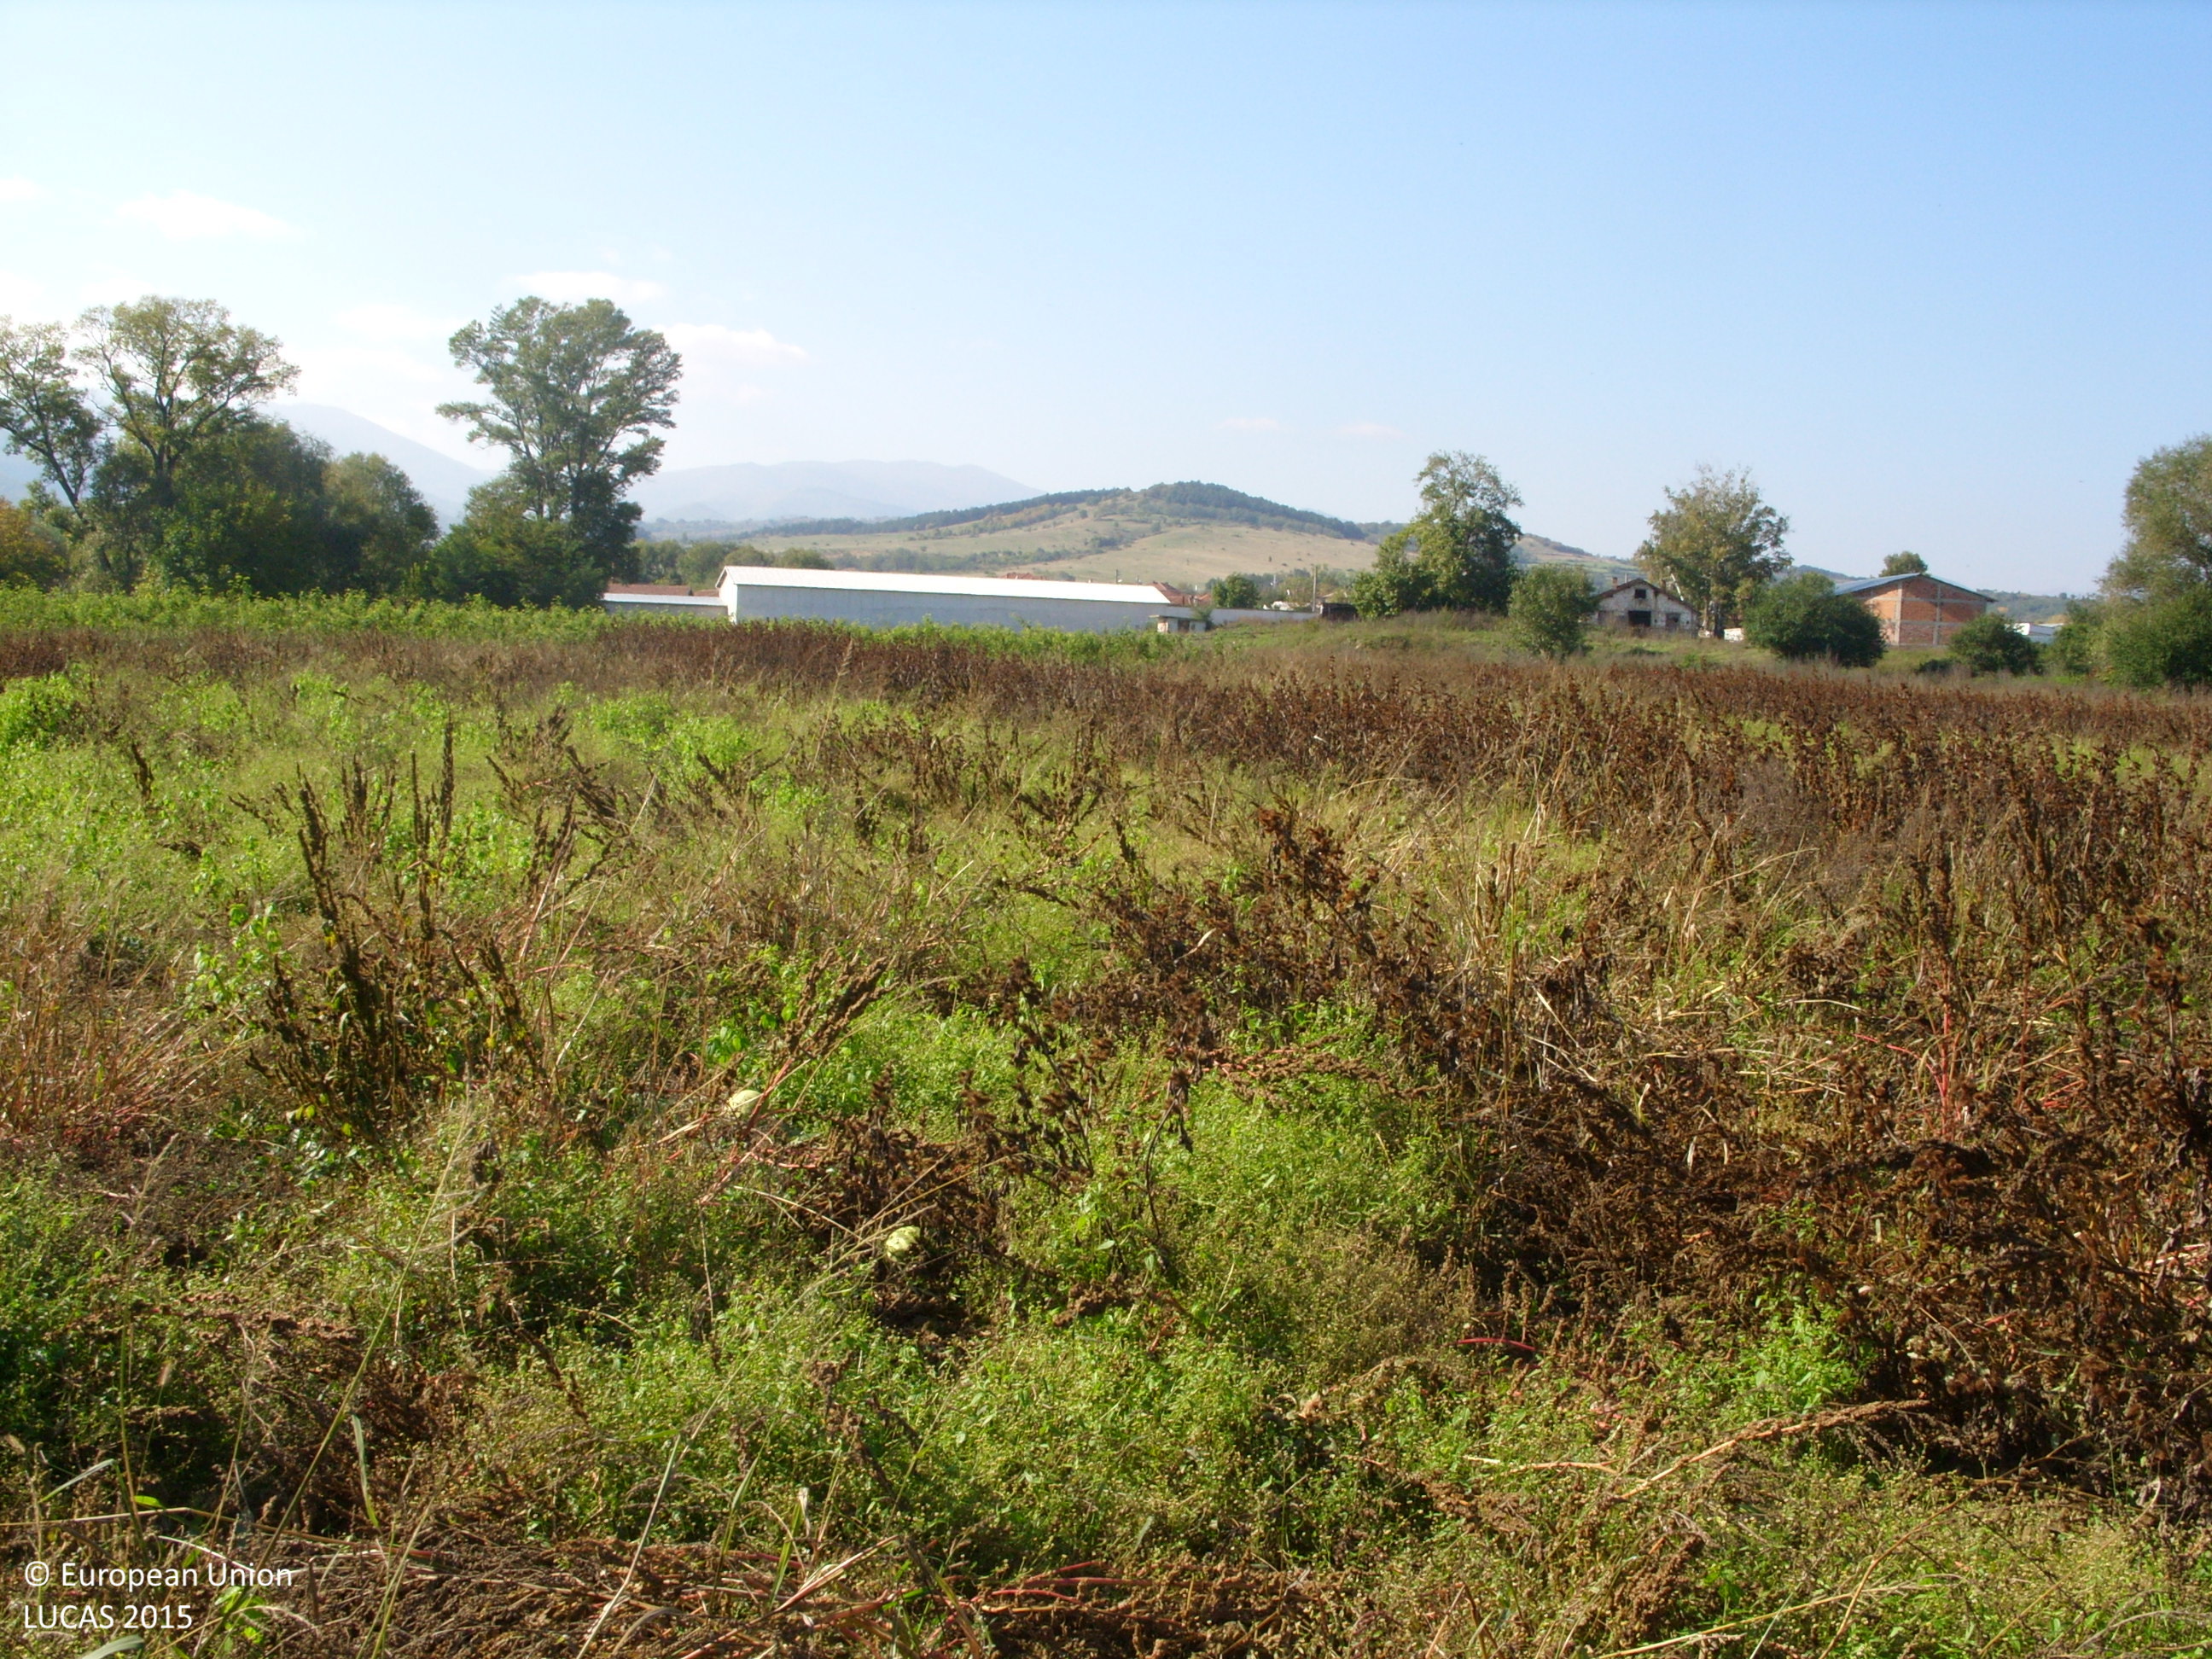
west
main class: Cropland
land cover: Other fresh vegetables
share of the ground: 25 - 50 %
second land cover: Spontaneously vegetated surfaces
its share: 50 - 75 %
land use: Agriculture (excluding fallow land and kitchen gardens)
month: October
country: BG
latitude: 42.6018
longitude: 24.6938
